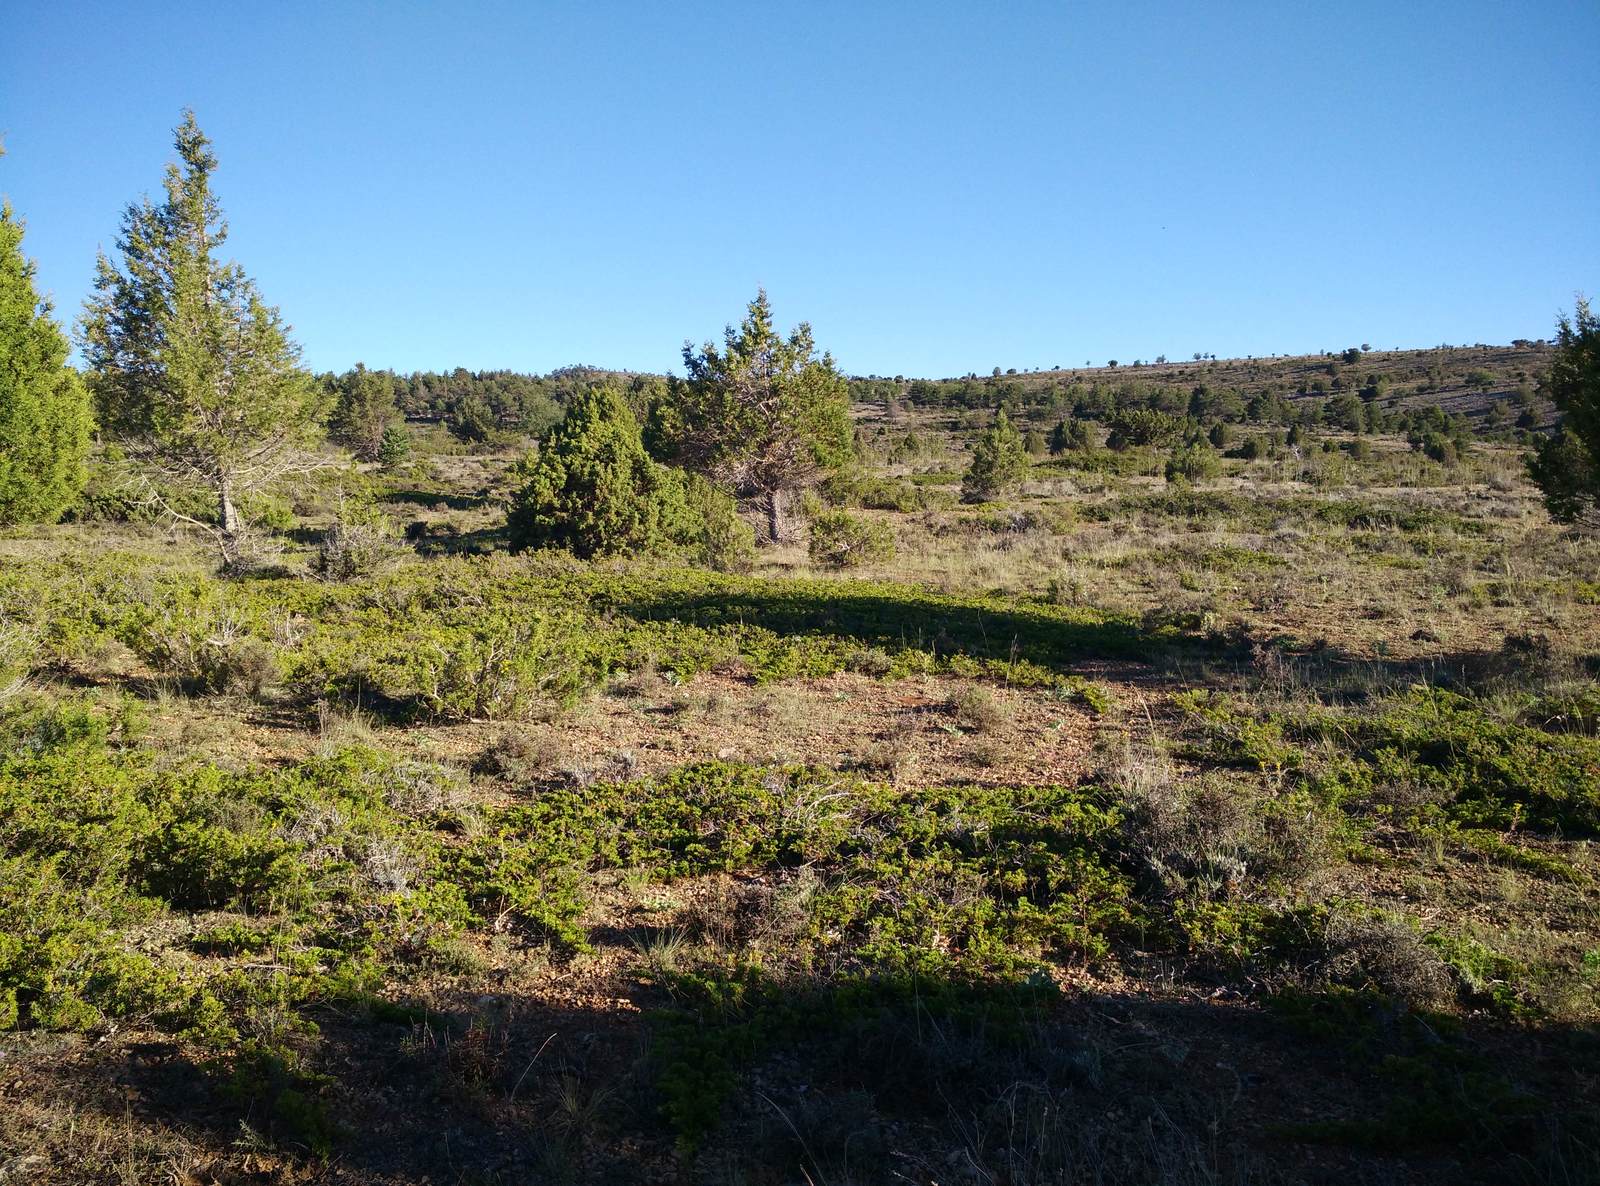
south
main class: Shrubland
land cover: Shrubland with sparse tree cover
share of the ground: 50 - 75 %
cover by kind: shrubs 50 %, unconsolidated bare surface 40 %, coniferous forest trees 5 %, herbaceous plants 5 %
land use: Semi-natural and natural areas not in use
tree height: > 5 m
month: June
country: ES
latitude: 40.6320
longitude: -1.7828
